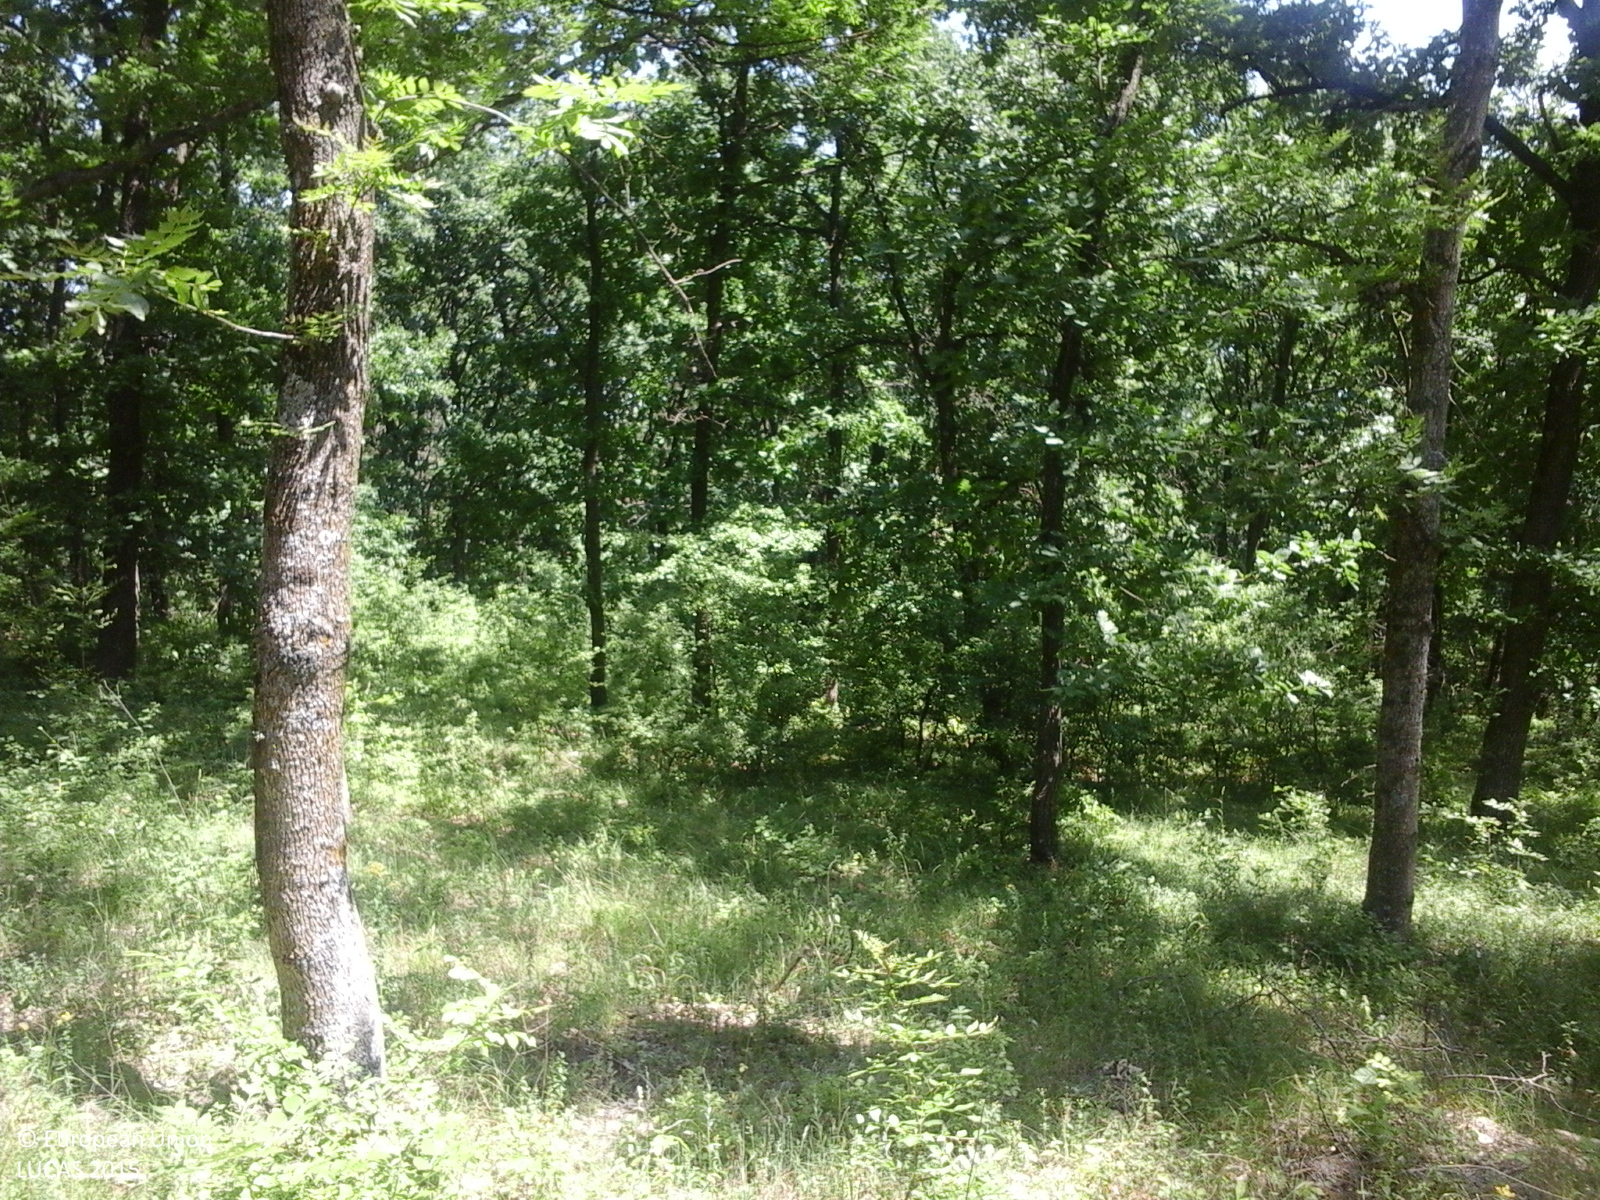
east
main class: Woodland
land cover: Broadleaved woodland
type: beech forest
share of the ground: > 75 %
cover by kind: broadleaved forest trees 100 %
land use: Forestry
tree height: > 5 m
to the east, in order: Broadleaved woodland
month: June
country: RO
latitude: 46.8097
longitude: 27.9363
